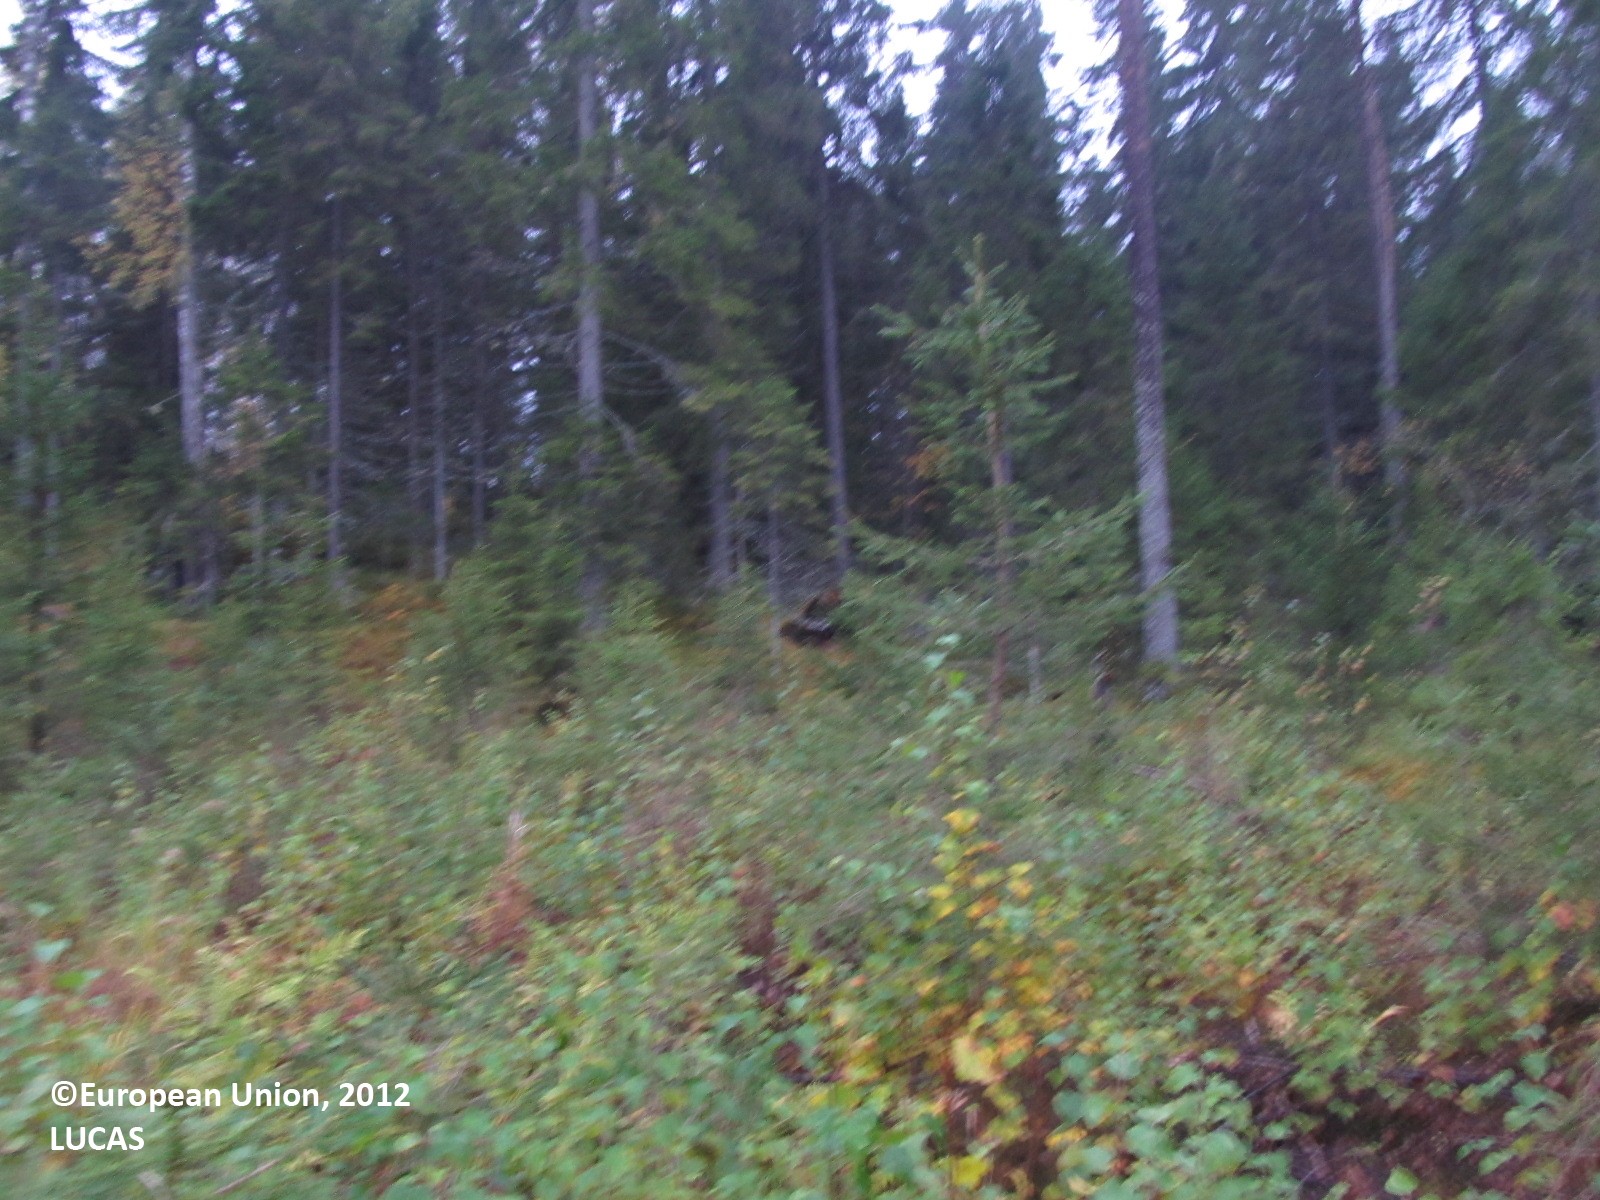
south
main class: Woodland
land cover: Spruce dominated mixed woodland
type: boreal forest
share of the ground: 50 - 75 %
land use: Forestry
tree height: < 5 m
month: September
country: FI
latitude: 62.2855
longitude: 28.2149
